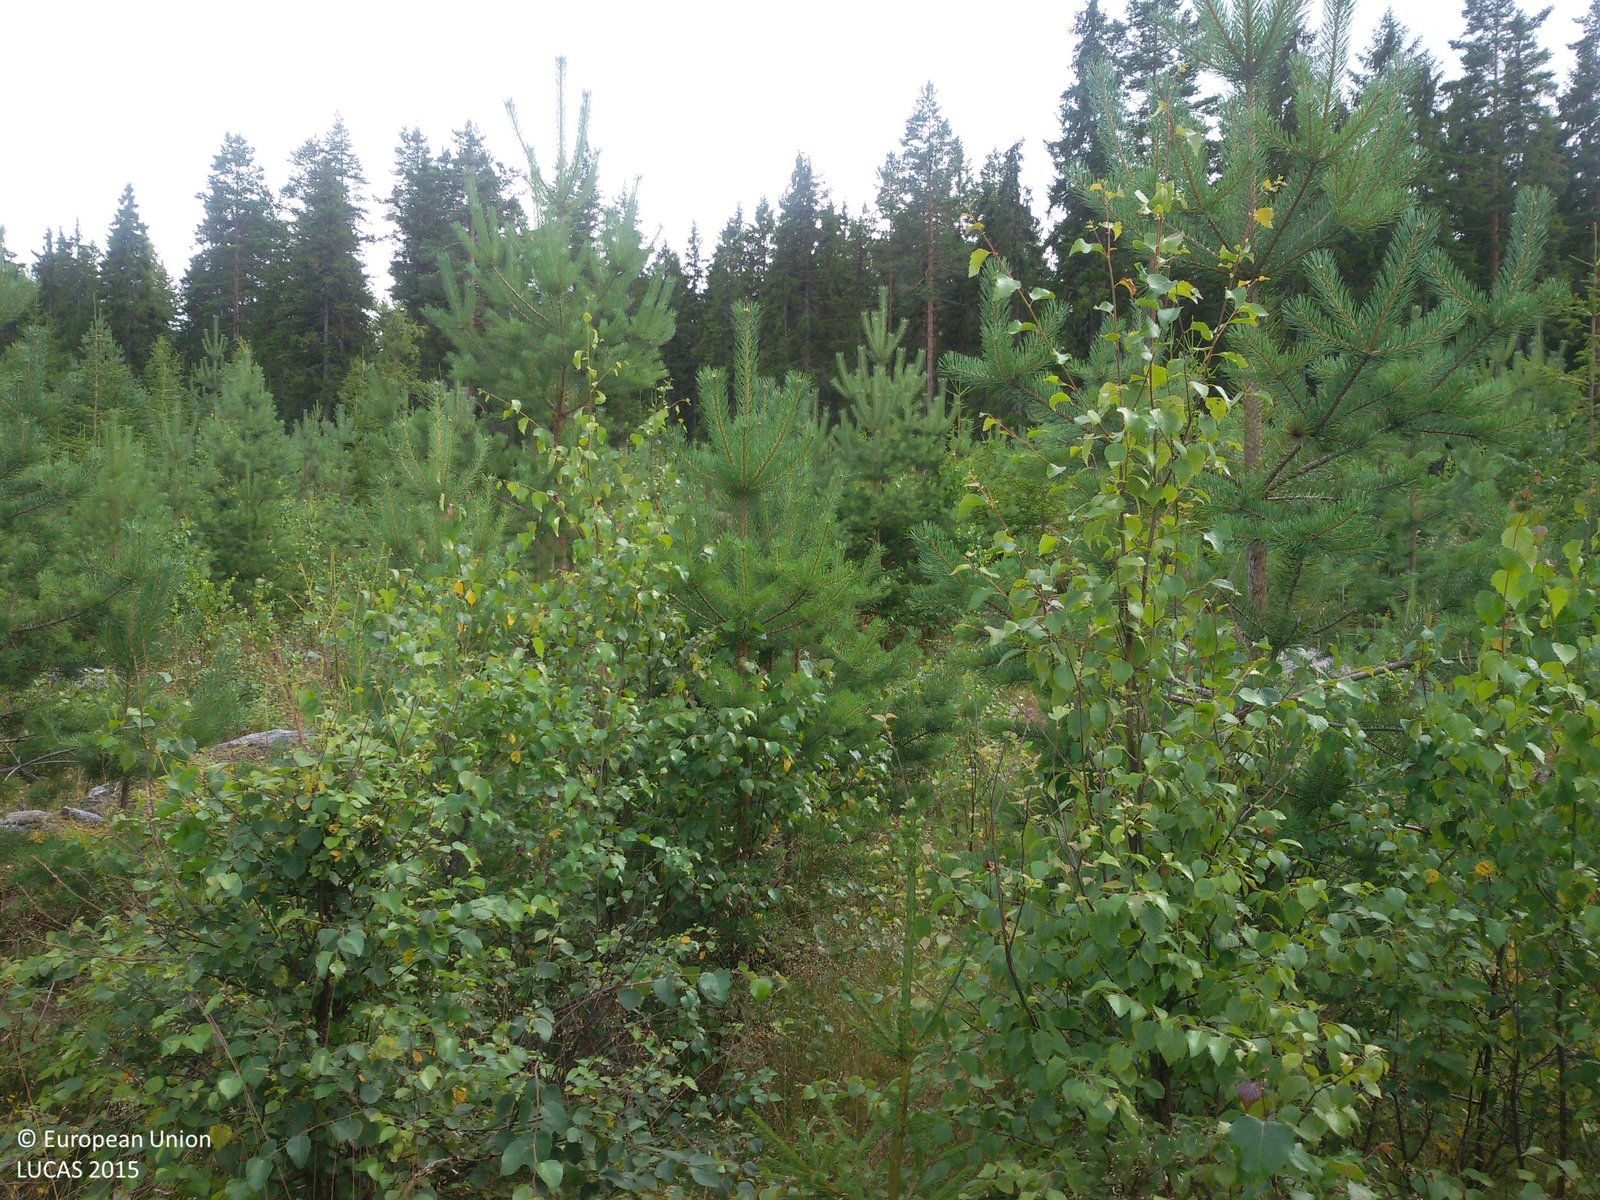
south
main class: Woodland
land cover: Pine dominated mixed woodland
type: boreal forest
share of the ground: > 75 %
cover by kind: coniferous forest trees 45 %, broadleaved forest trees 40 %, herbaceous plants 15 %
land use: Forestry
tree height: < 5 m
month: August
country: SE
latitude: 60.4100
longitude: 16.5067
